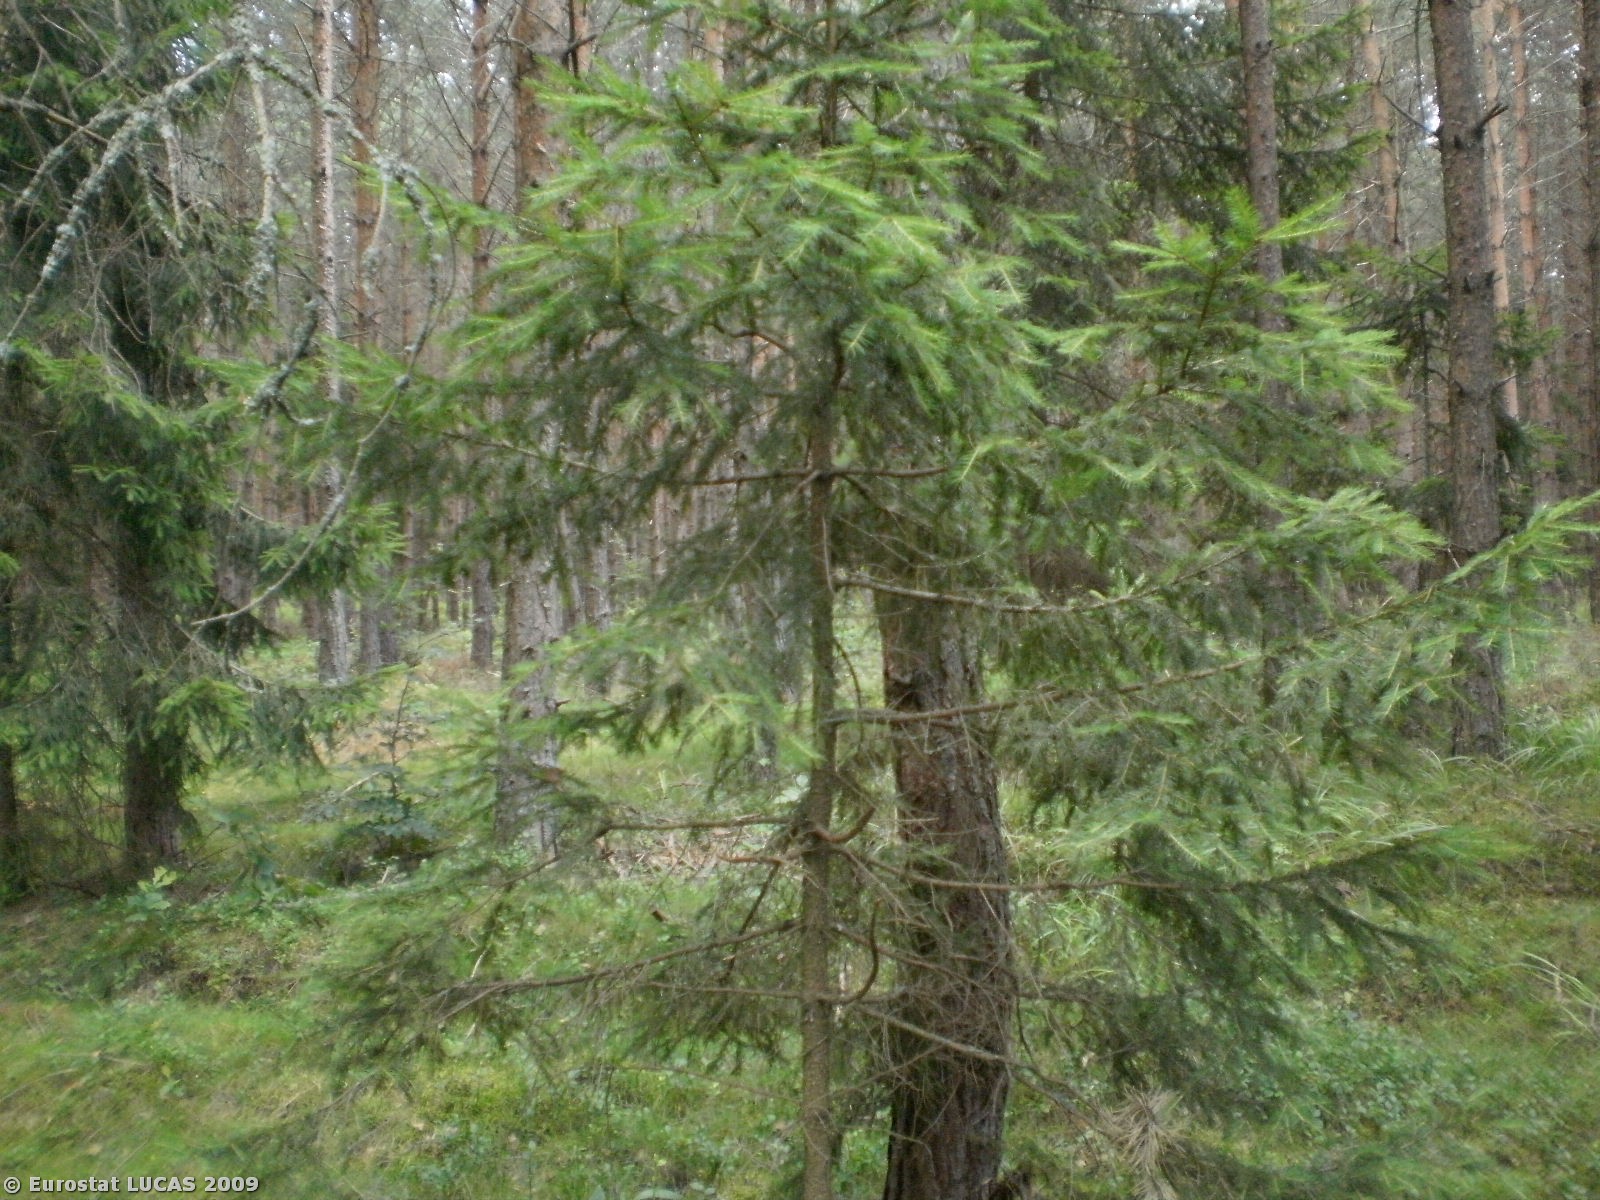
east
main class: Woodland
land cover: Coniferous woodland
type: hemiboreal forest and nemoral coniferous forest and mixed broadleaved-coniferous forest
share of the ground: > 75 %
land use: Forestry
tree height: > 5 m
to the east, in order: Coniferous woodland; Mixed woodland; Grassland without tree/shrub cover
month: July
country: PL
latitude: 53.5661
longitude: 21.0511
